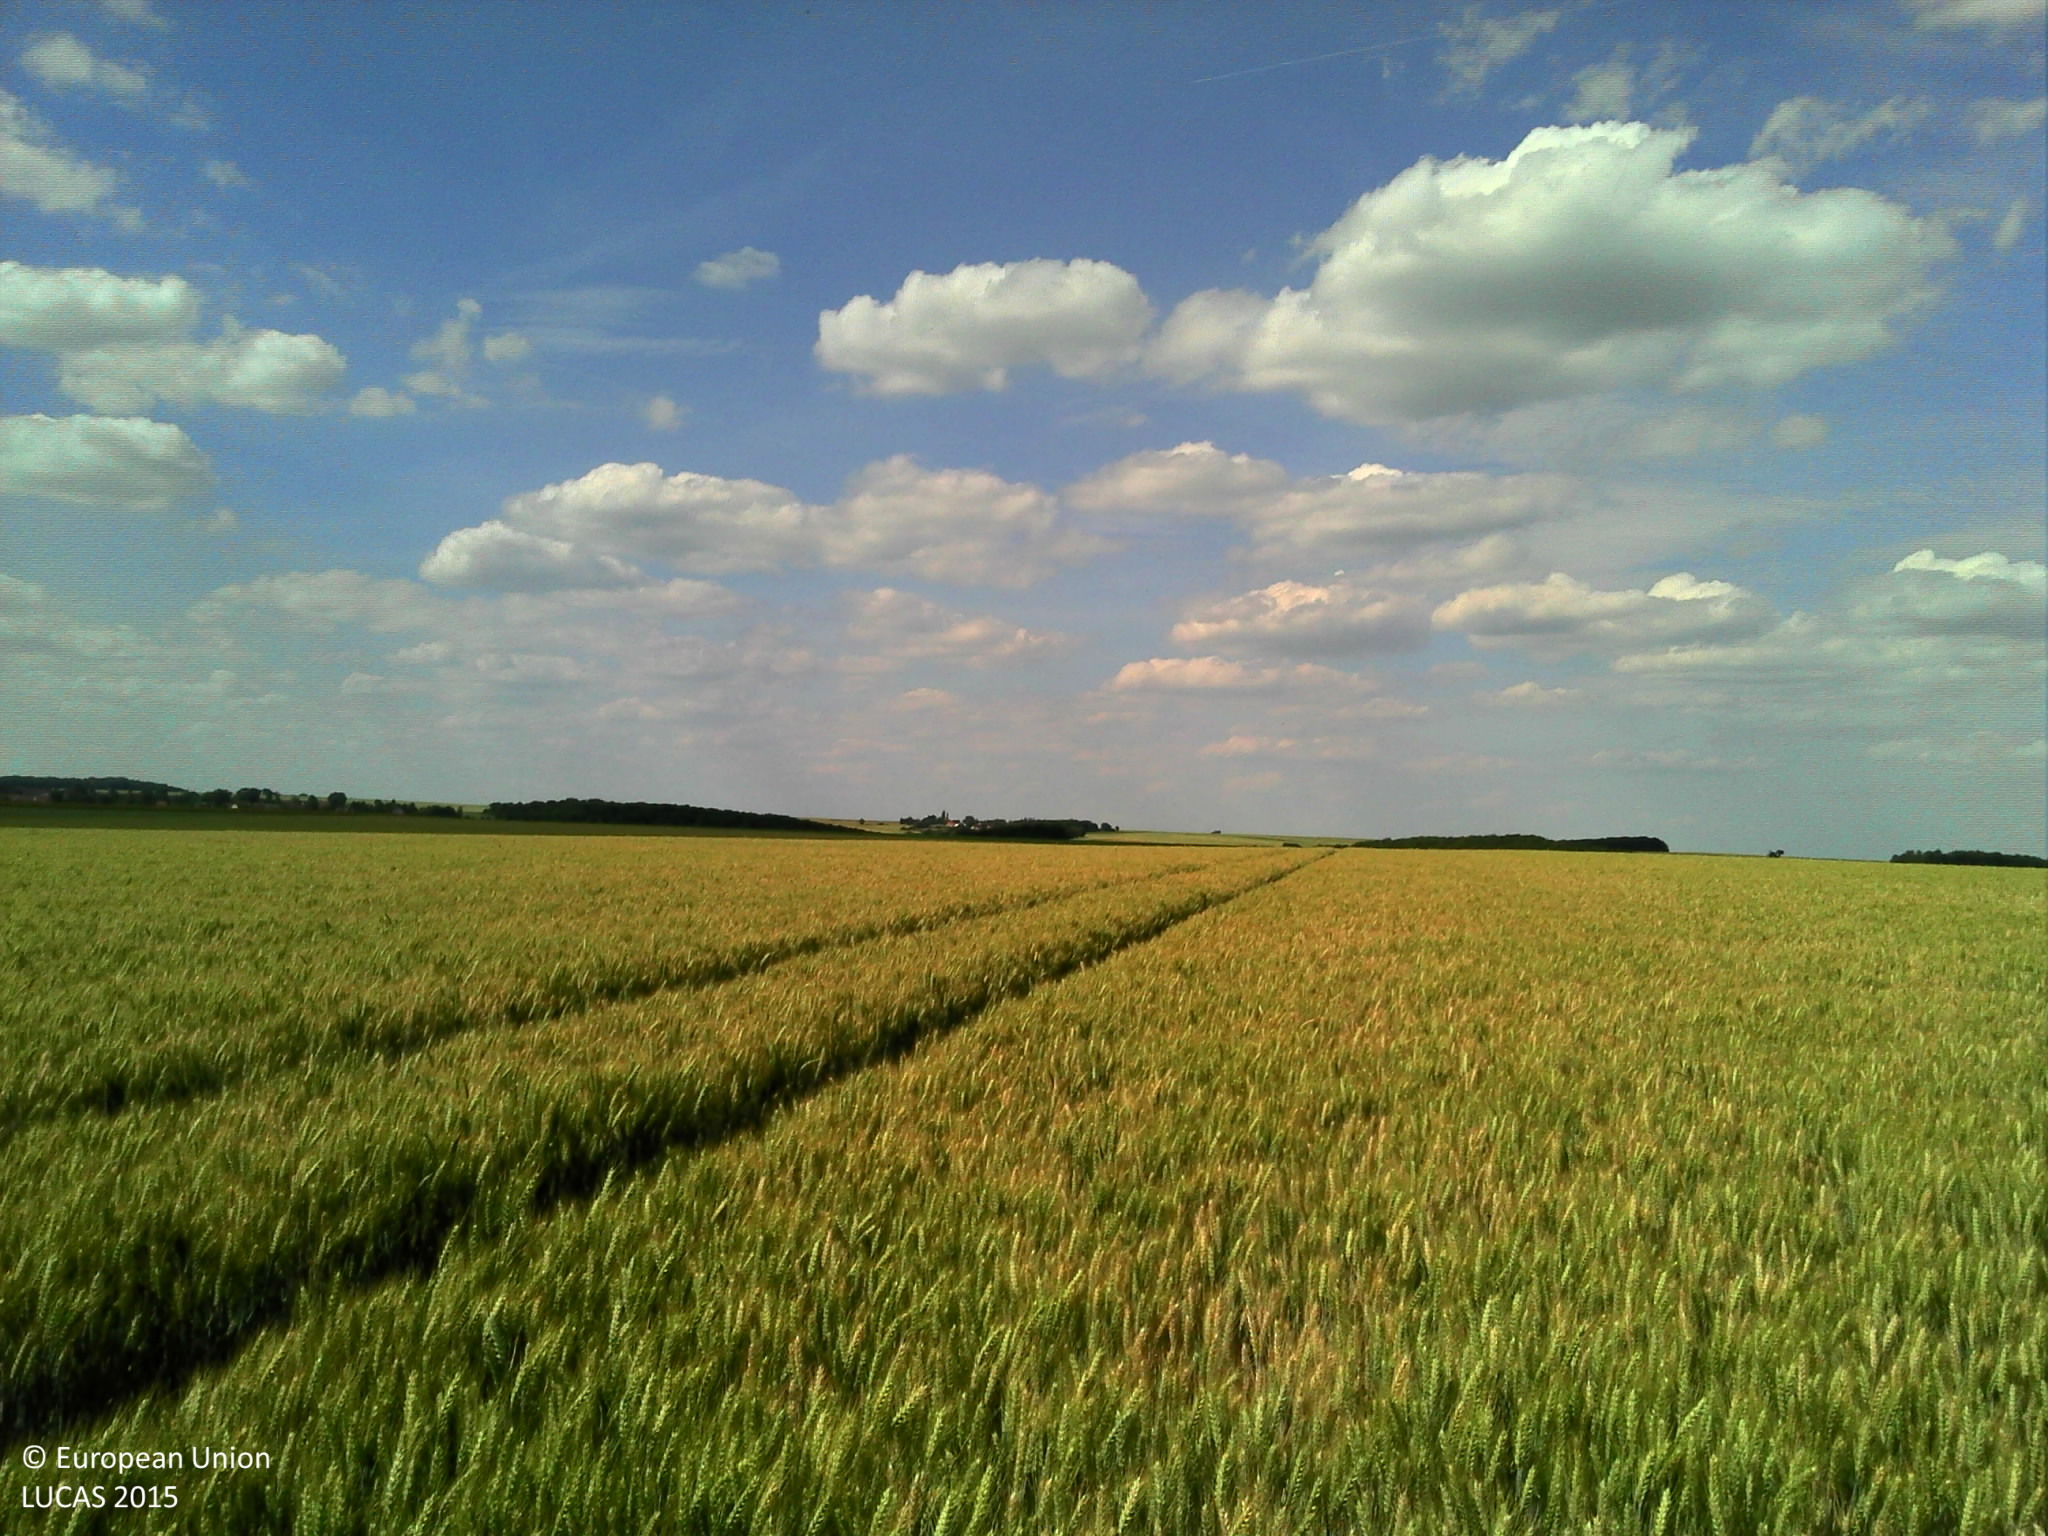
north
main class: Cropland
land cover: Common wheat
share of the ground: > 75 %
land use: Agriculture (excluding fallow land and kitchen gardens)
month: June
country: FR
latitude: 49.3974
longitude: 2.5338
